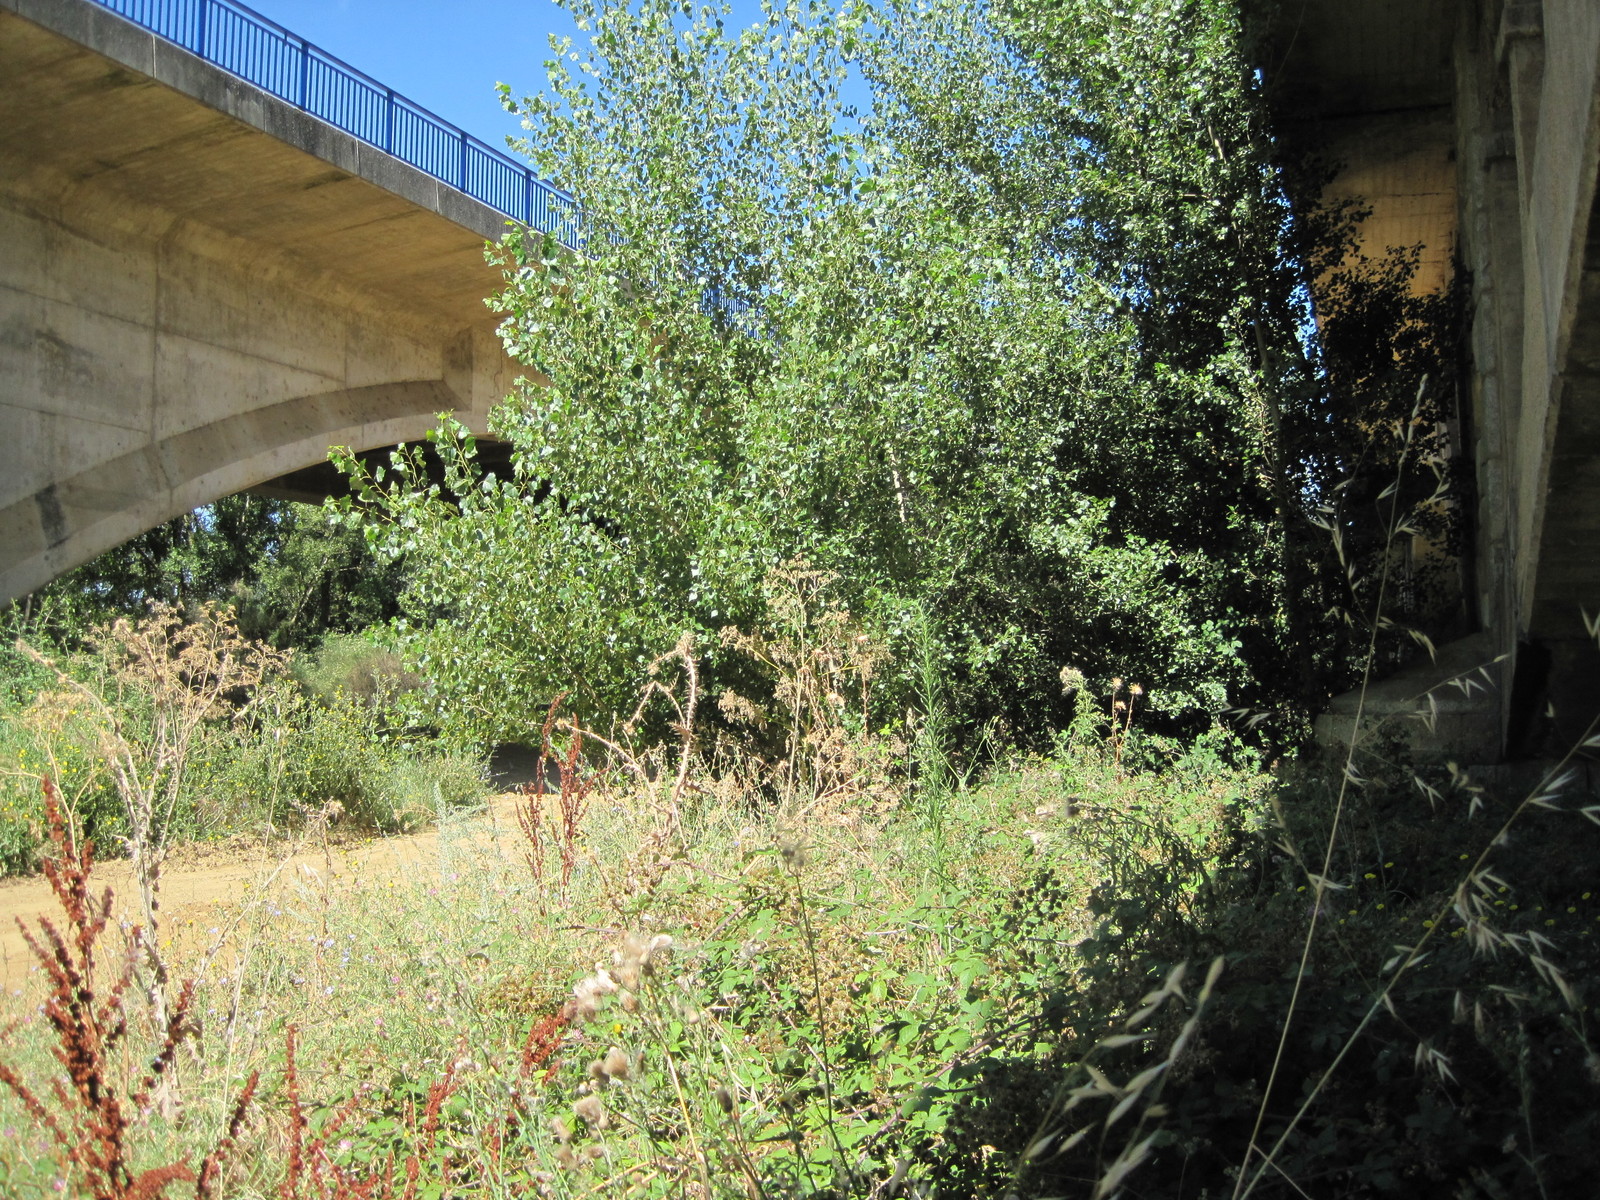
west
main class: Artificial land
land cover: Non built-up linear features
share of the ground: > 75 %
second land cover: Grassland without tree/shrub cover
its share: > 75 %
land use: Road transport
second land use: Forestry
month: July
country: ES
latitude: 41.9837
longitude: -5.6241
